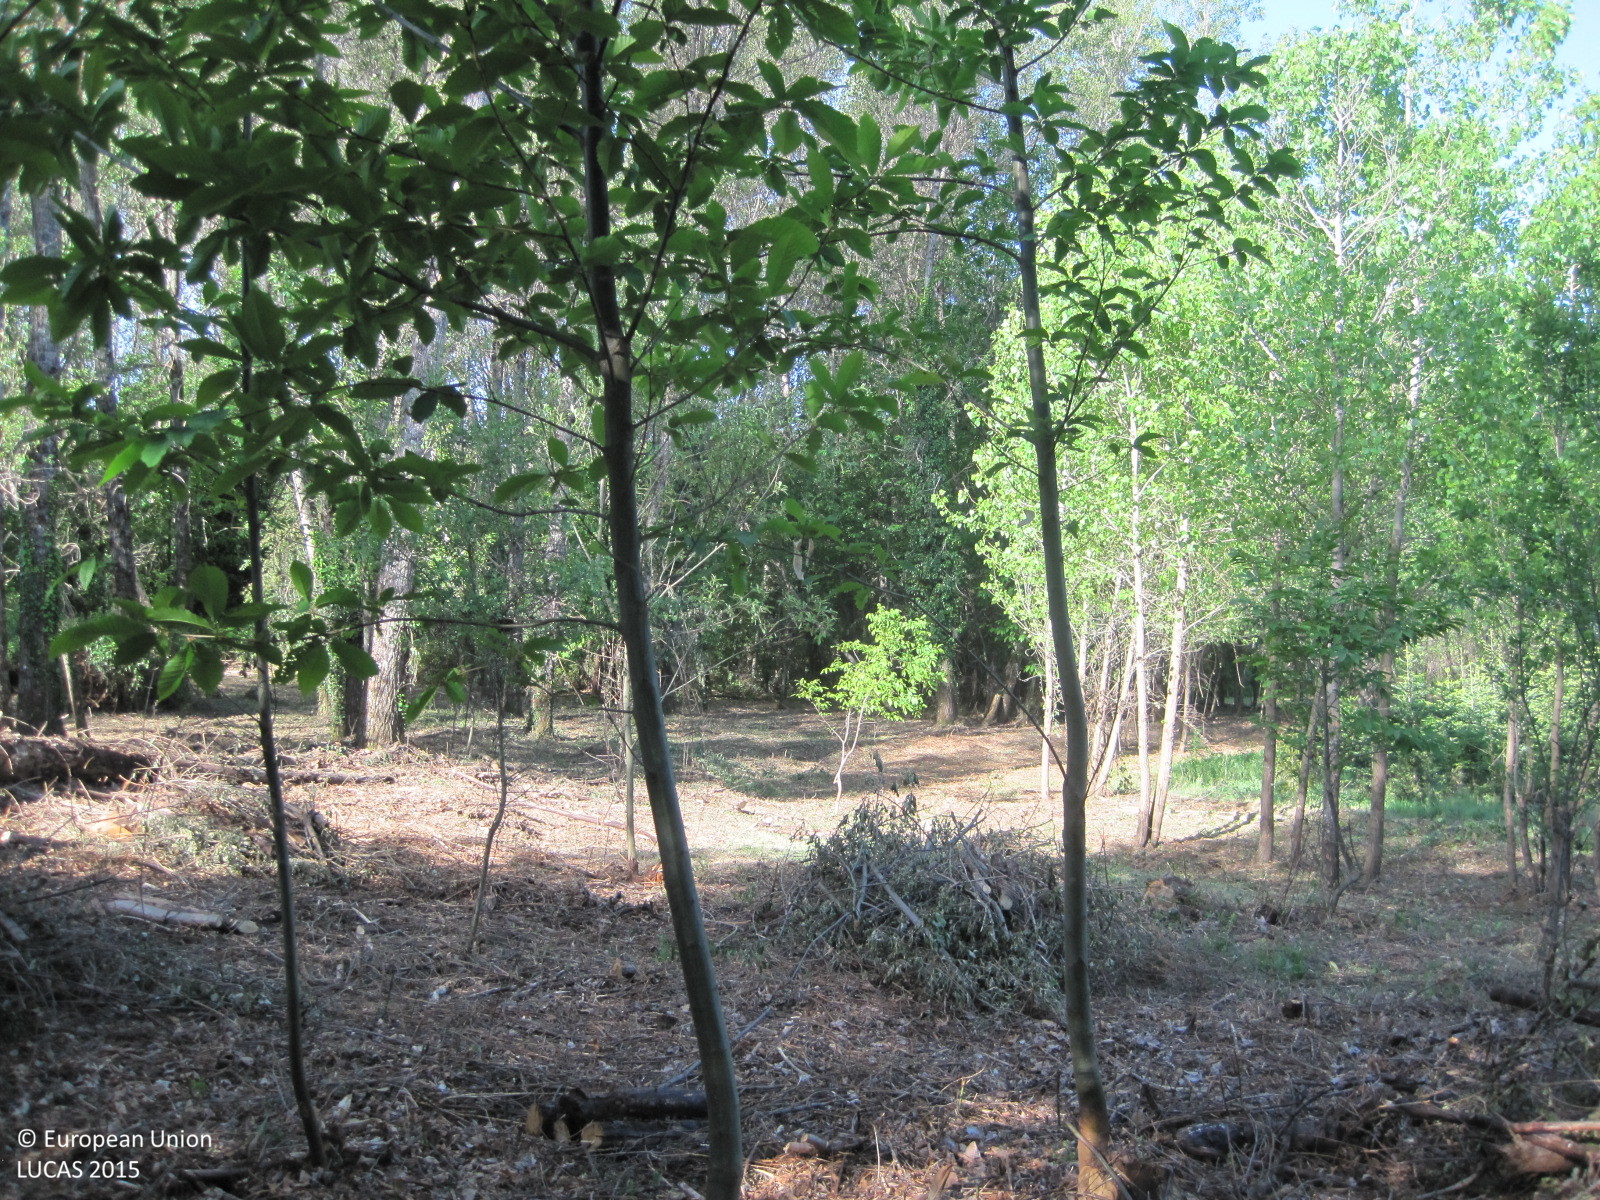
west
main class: Grassland
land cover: Grassland without tree/shrub cover
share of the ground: > 75 %
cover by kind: herbaceous plants 100 %
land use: Agriculture (excluding fallow land and kitchen gardens)
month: May
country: ES
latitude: 40.1395
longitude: -4.7320
